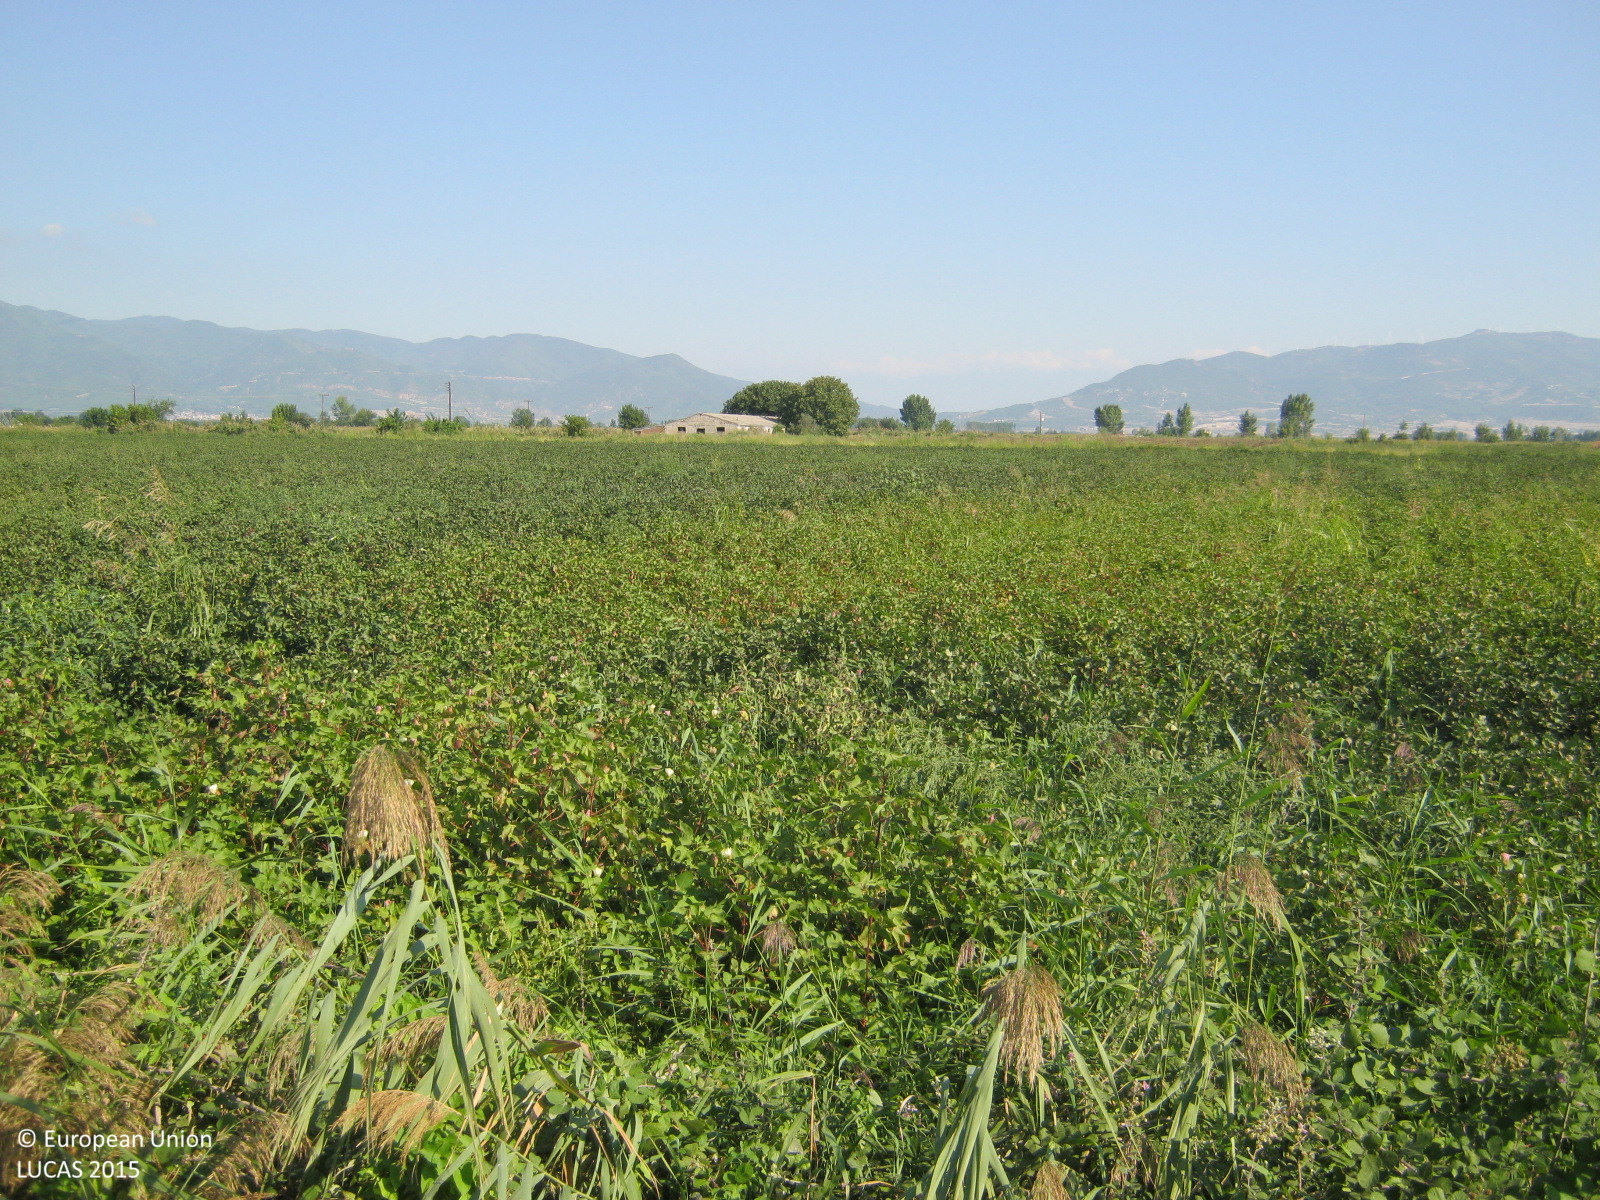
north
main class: Cropland
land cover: Cotton
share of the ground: > 75 %
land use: Agriculture (excluding fallow land and kitchen gardens)
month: September
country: GR
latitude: 41.2037
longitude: 23.3150
